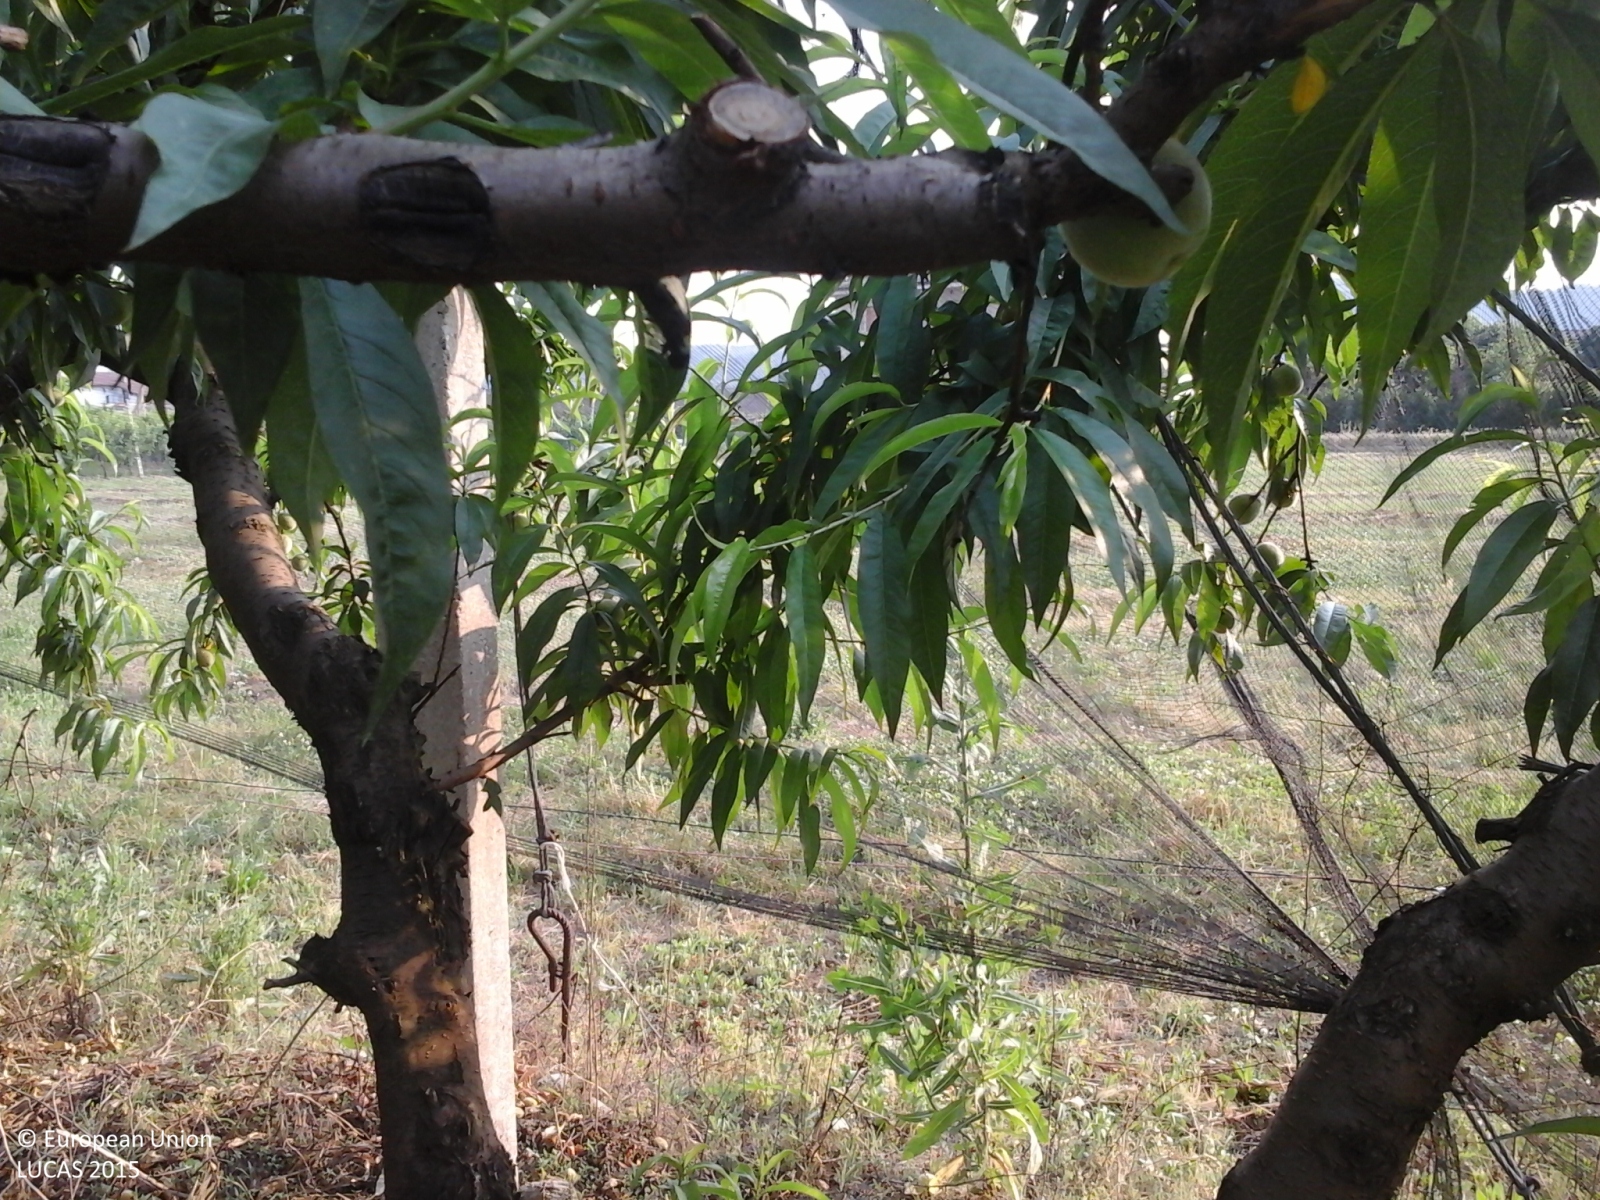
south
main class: Cropland
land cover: Other fruit trees and berries
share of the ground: 50 - 75 %
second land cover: Grassland without tree/shrub cover
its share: > 75 %
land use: Agriculture (excluding fallow land and kitchen gardens)
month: June
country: IT
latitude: 45.5011
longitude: 10.8305
